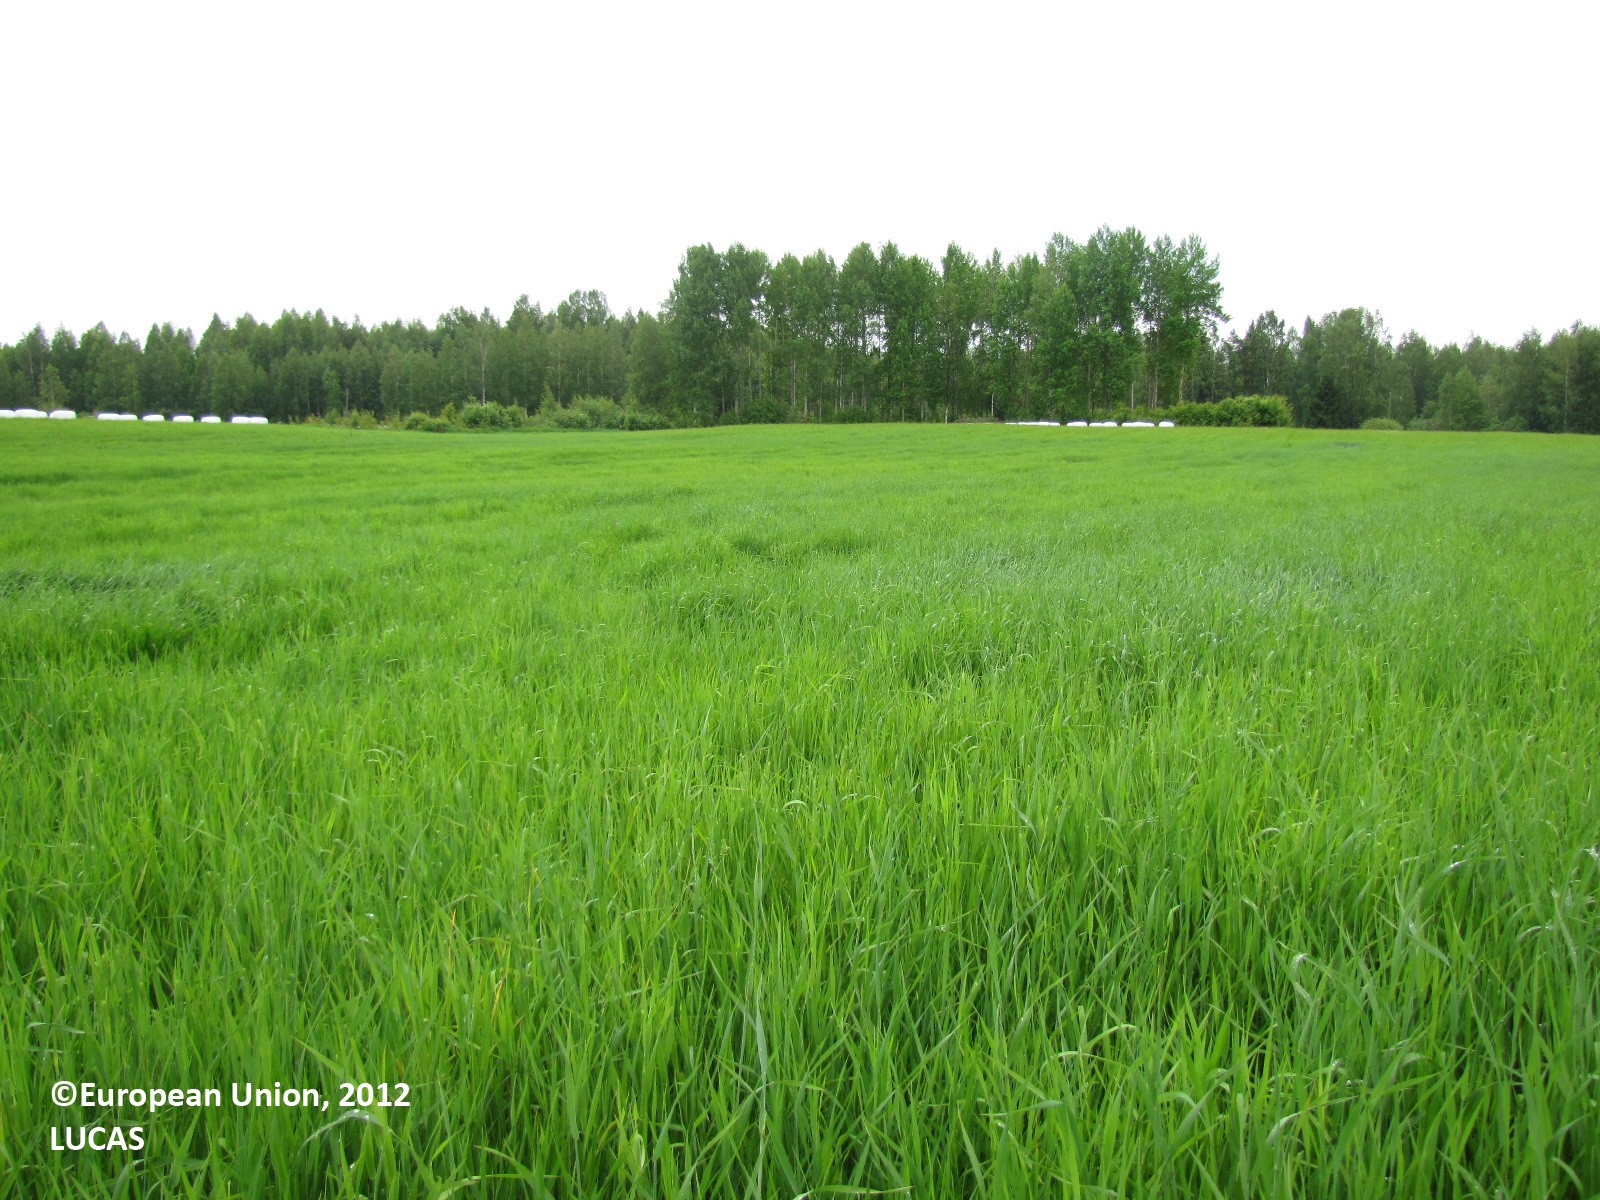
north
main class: Cropland
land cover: Temporary grasslands
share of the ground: > 75 %
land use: Agriculture (excluding fallow land and kitchen gardens)
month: June
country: FI
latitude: 61.4814
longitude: 24.6913
